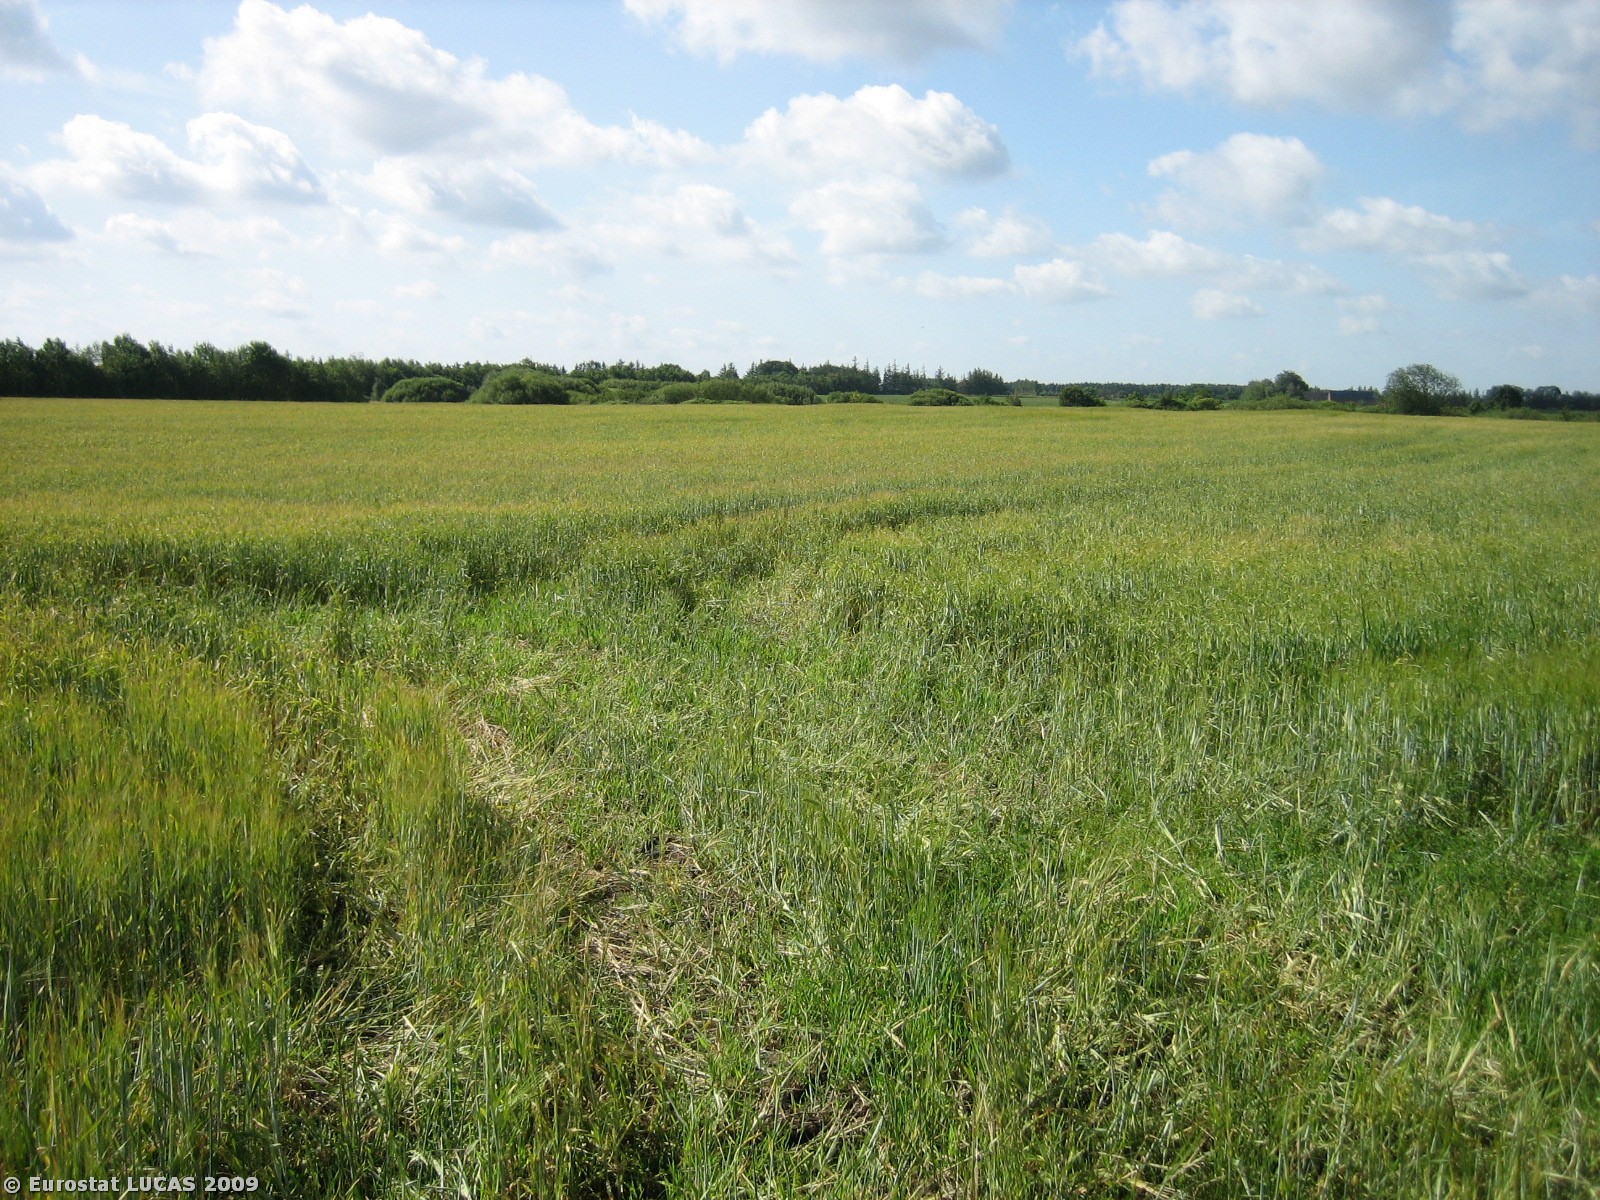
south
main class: Cropland
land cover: Barley
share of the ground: > 75 %
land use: Agriculture (excluding fallow land and kitchen gardens)
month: July
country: DK
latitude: 55.7328
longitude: 8.8068
